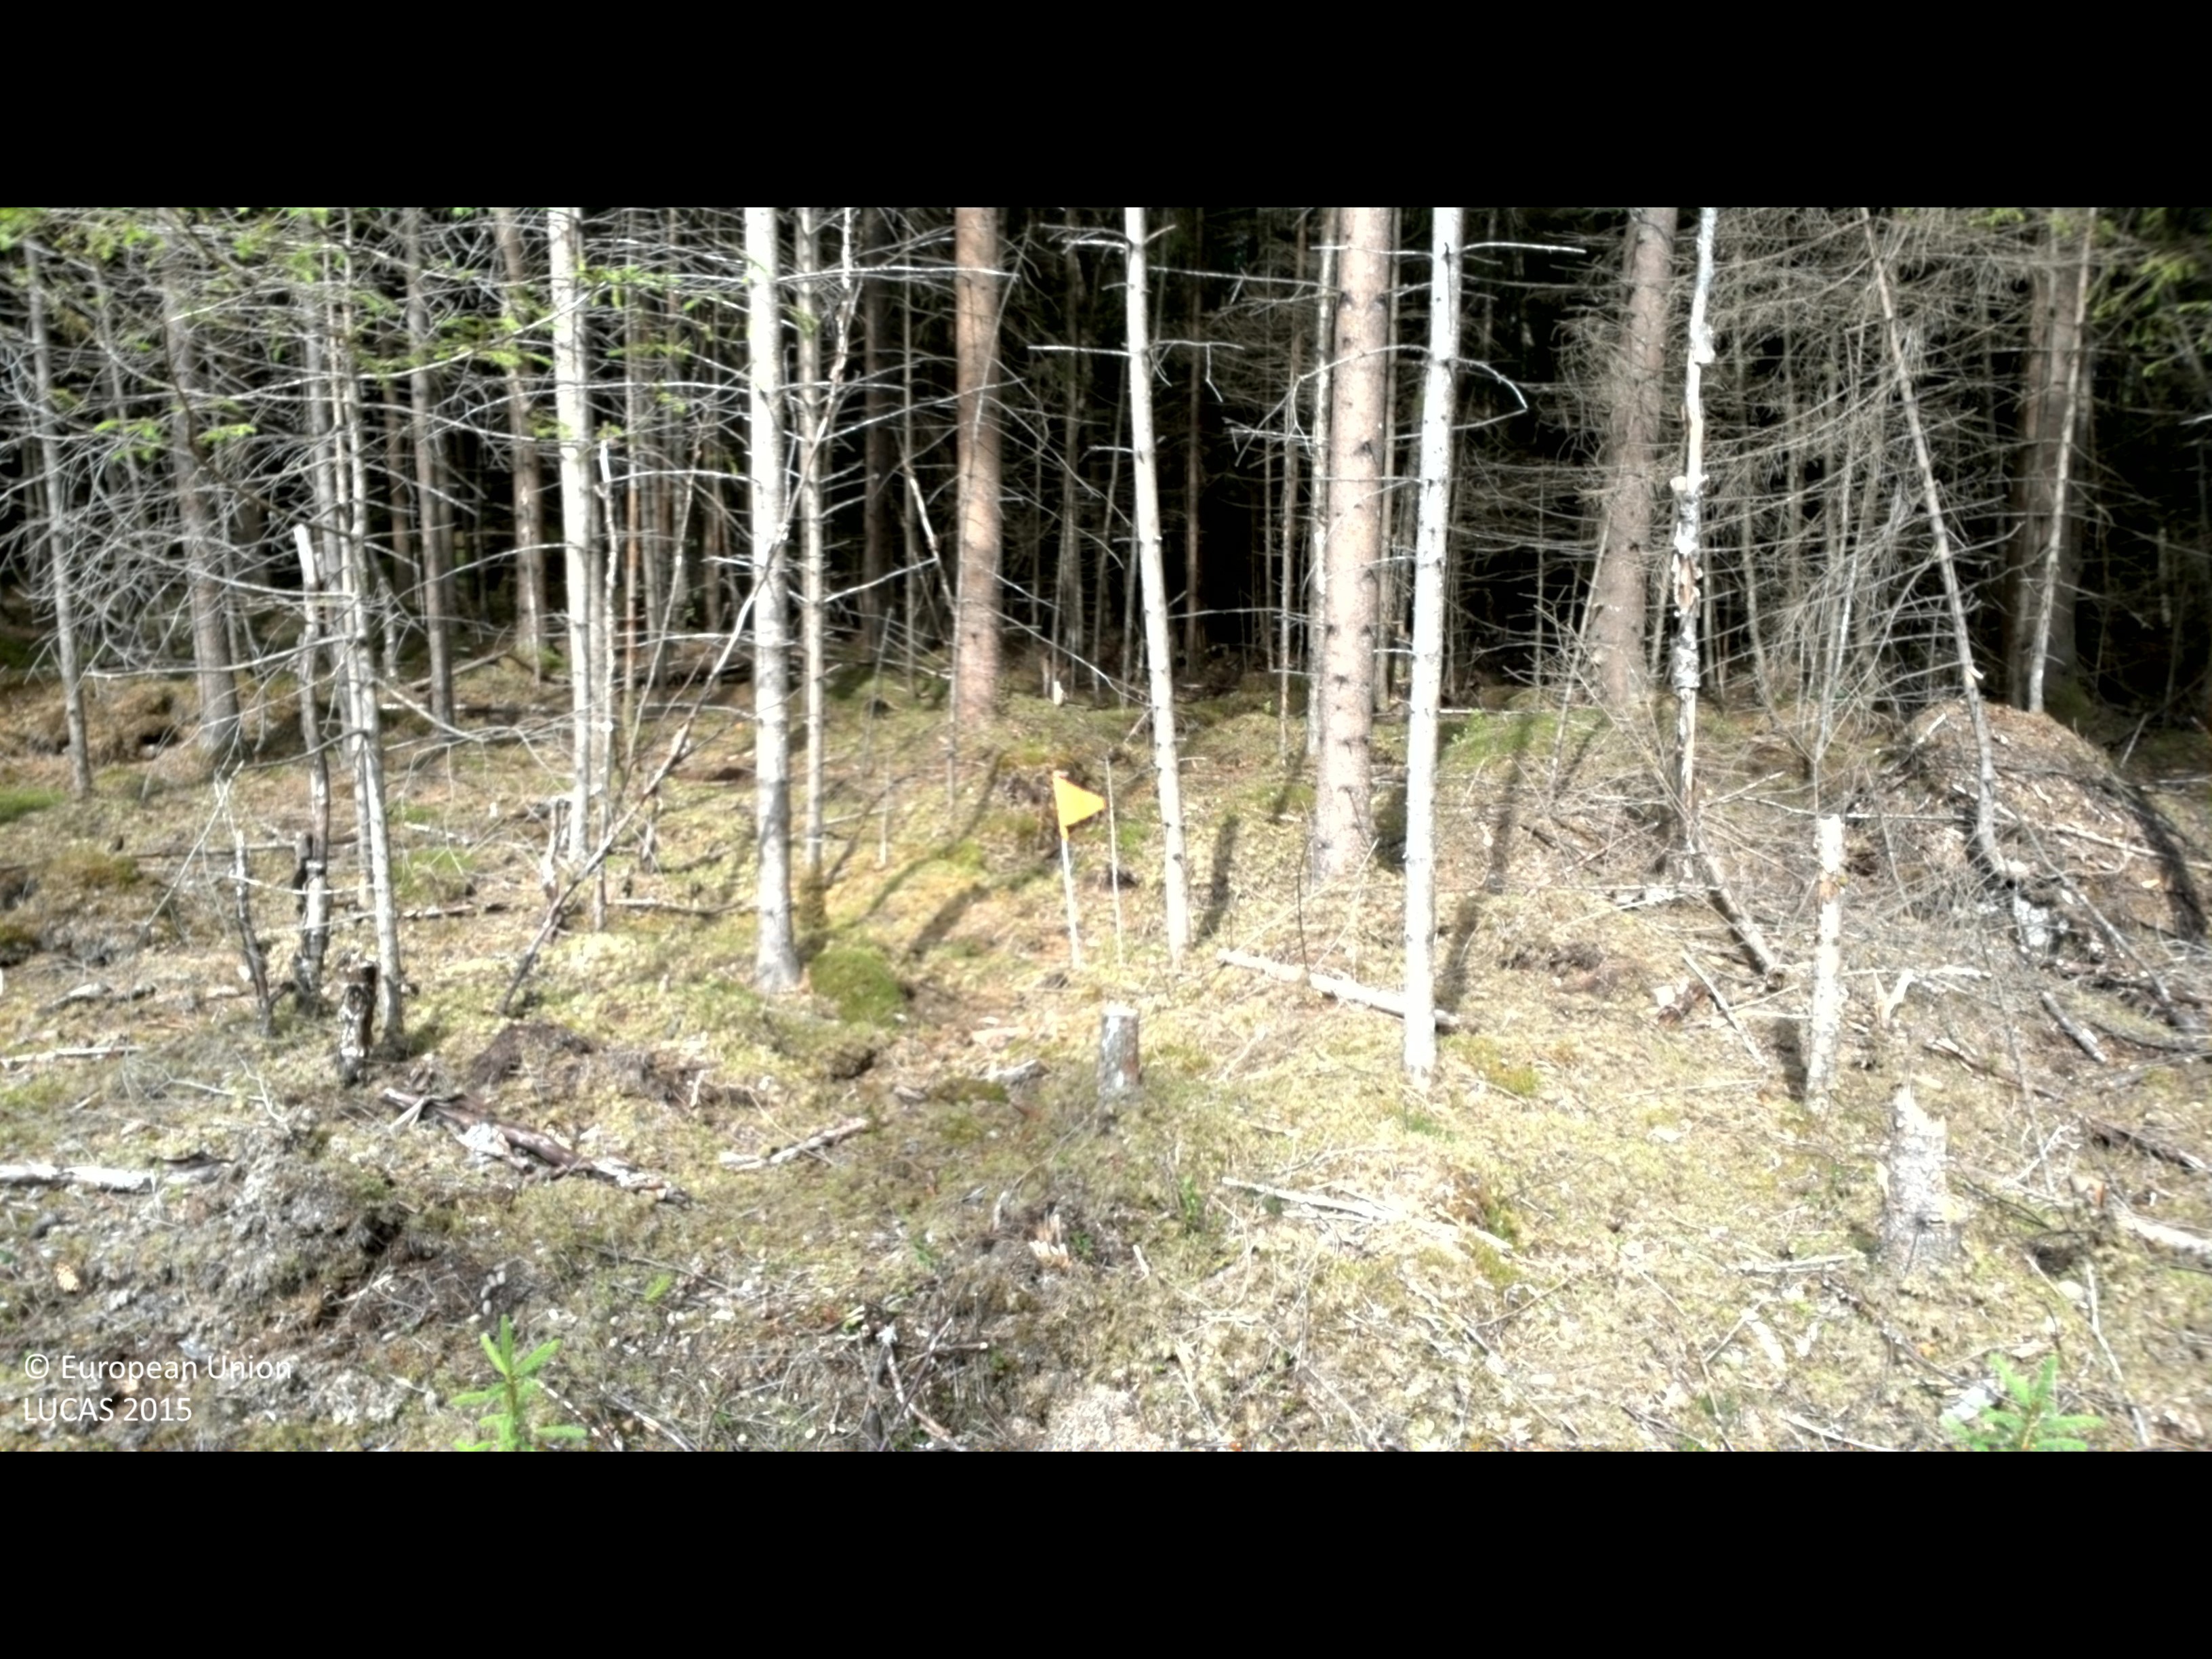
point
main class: Woodland
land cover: Spruce dominated coniferous woodland
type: boreal forest
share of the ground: 50 - 75 %
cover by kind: coniferous forest trees 55 %, lichens and mosses 35 %, unconsolidated bare surface 10 %
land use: Forestry
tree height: > 5 m
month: August
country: SE
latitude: 56.4479
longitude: 14.5888
